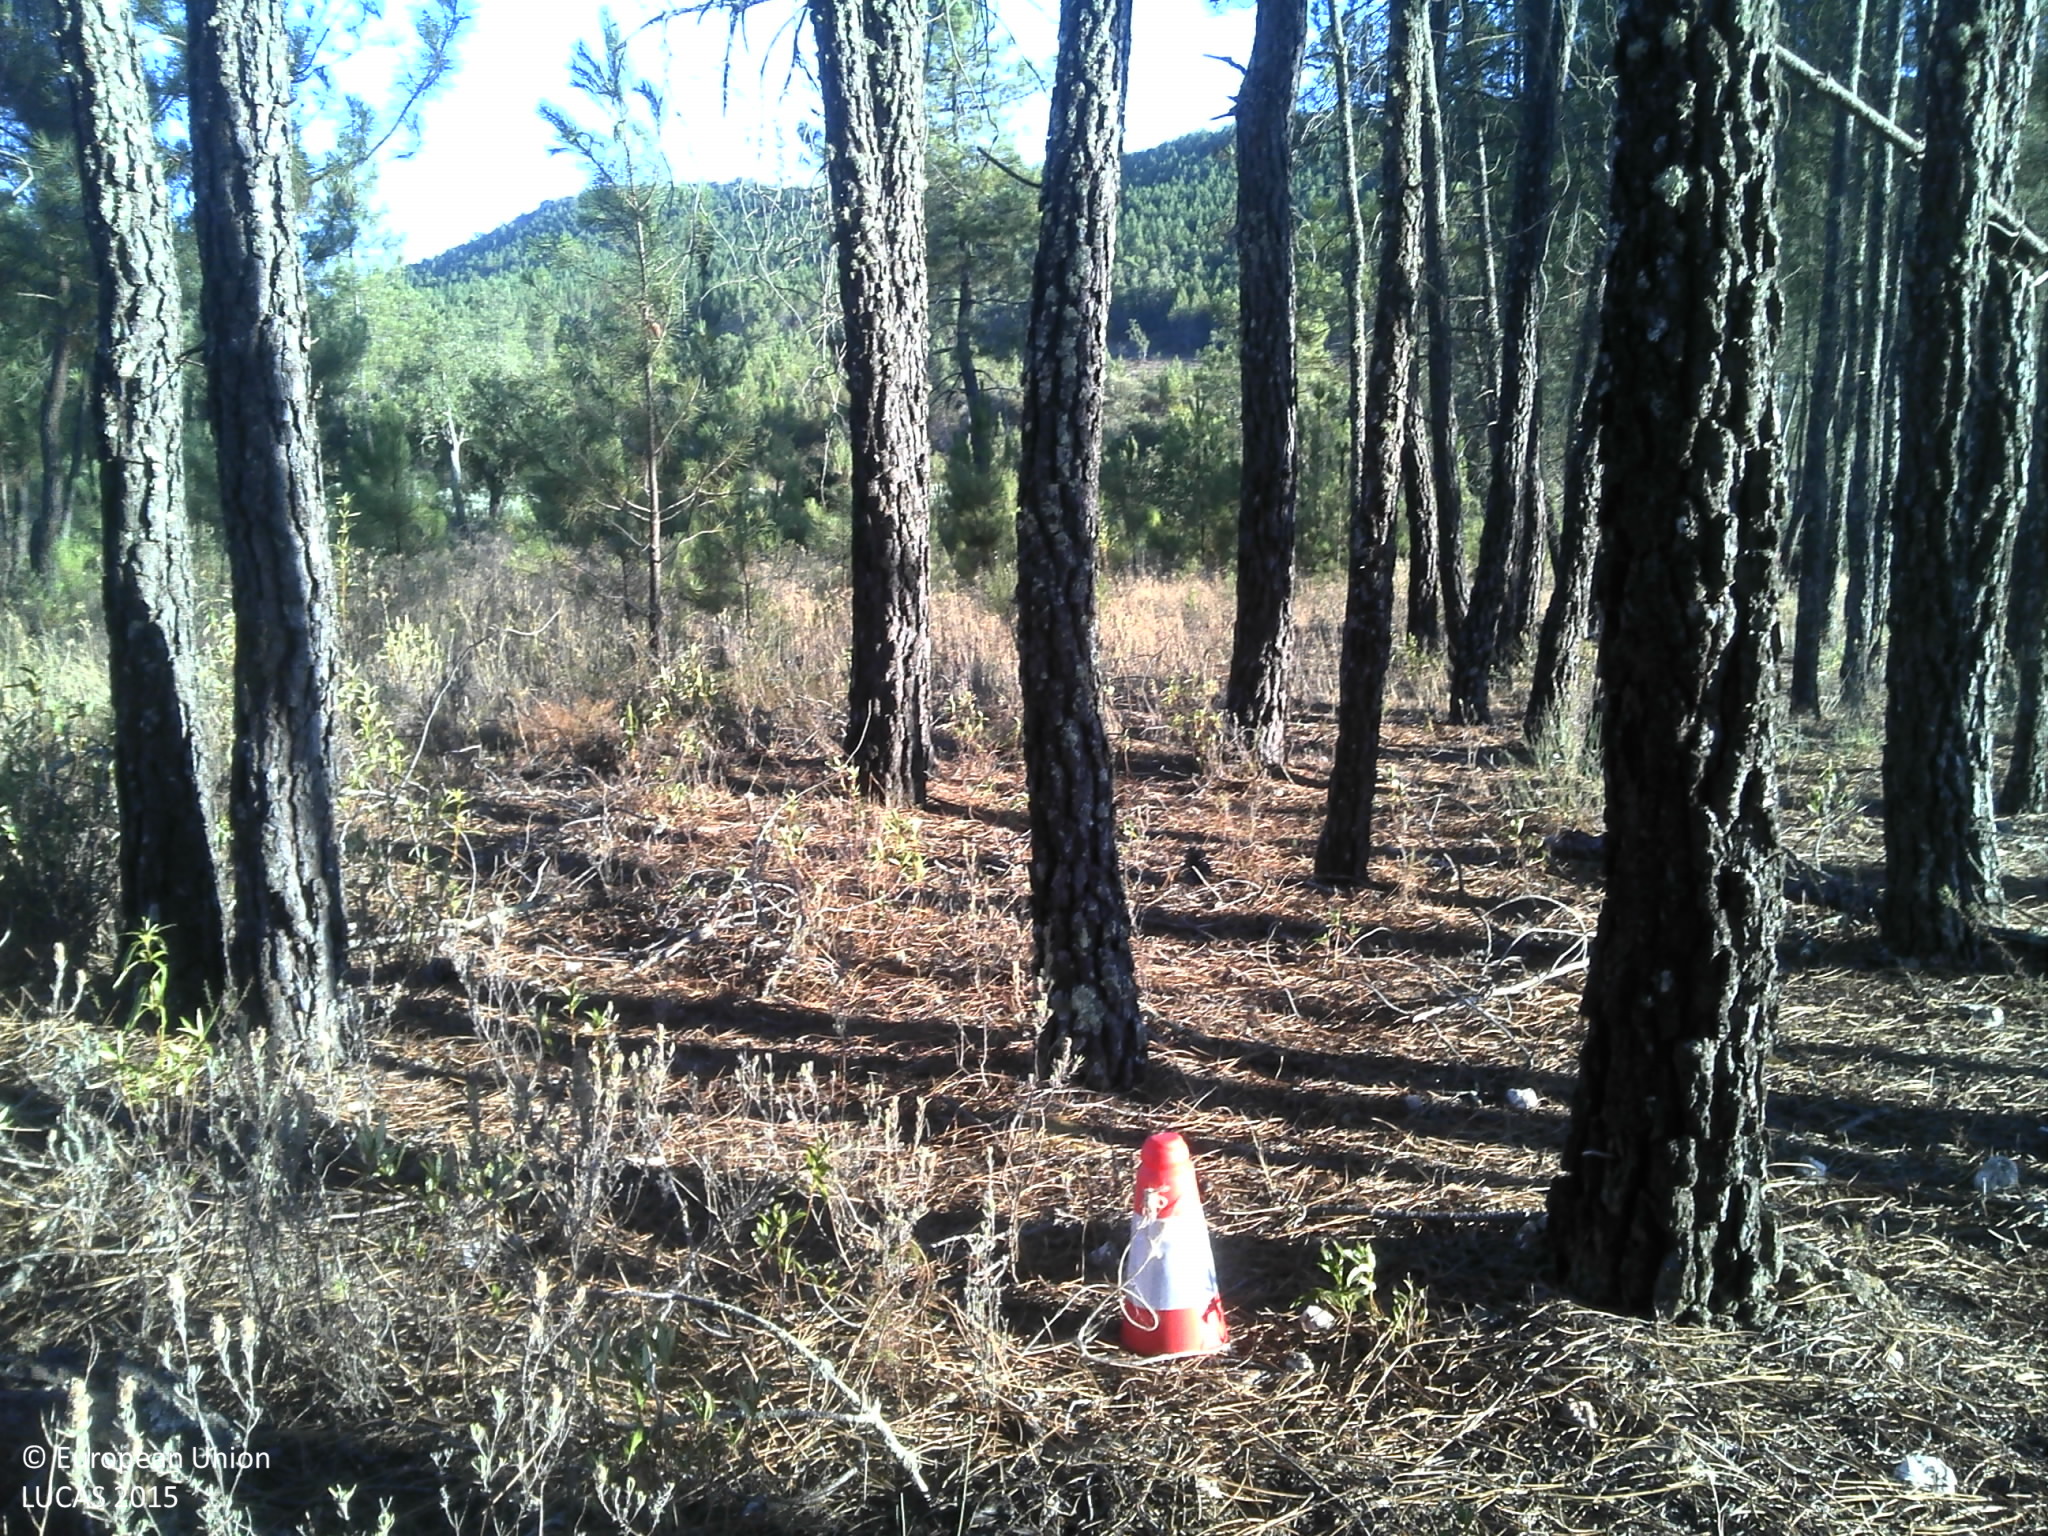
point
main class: Woodland
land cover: Pine dominated coniferous woodland
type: coniferous forest of the mediterranean region
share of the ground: 50 - 75 %
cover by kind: coniferous forest trees 70 %, unconsolidated bare surface 20 %, shrubs 5 %, herbaceous plants 5 %
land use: Forestry
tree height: > 5 m
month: July
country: PT
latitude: 39.9363
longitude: -7.5987
